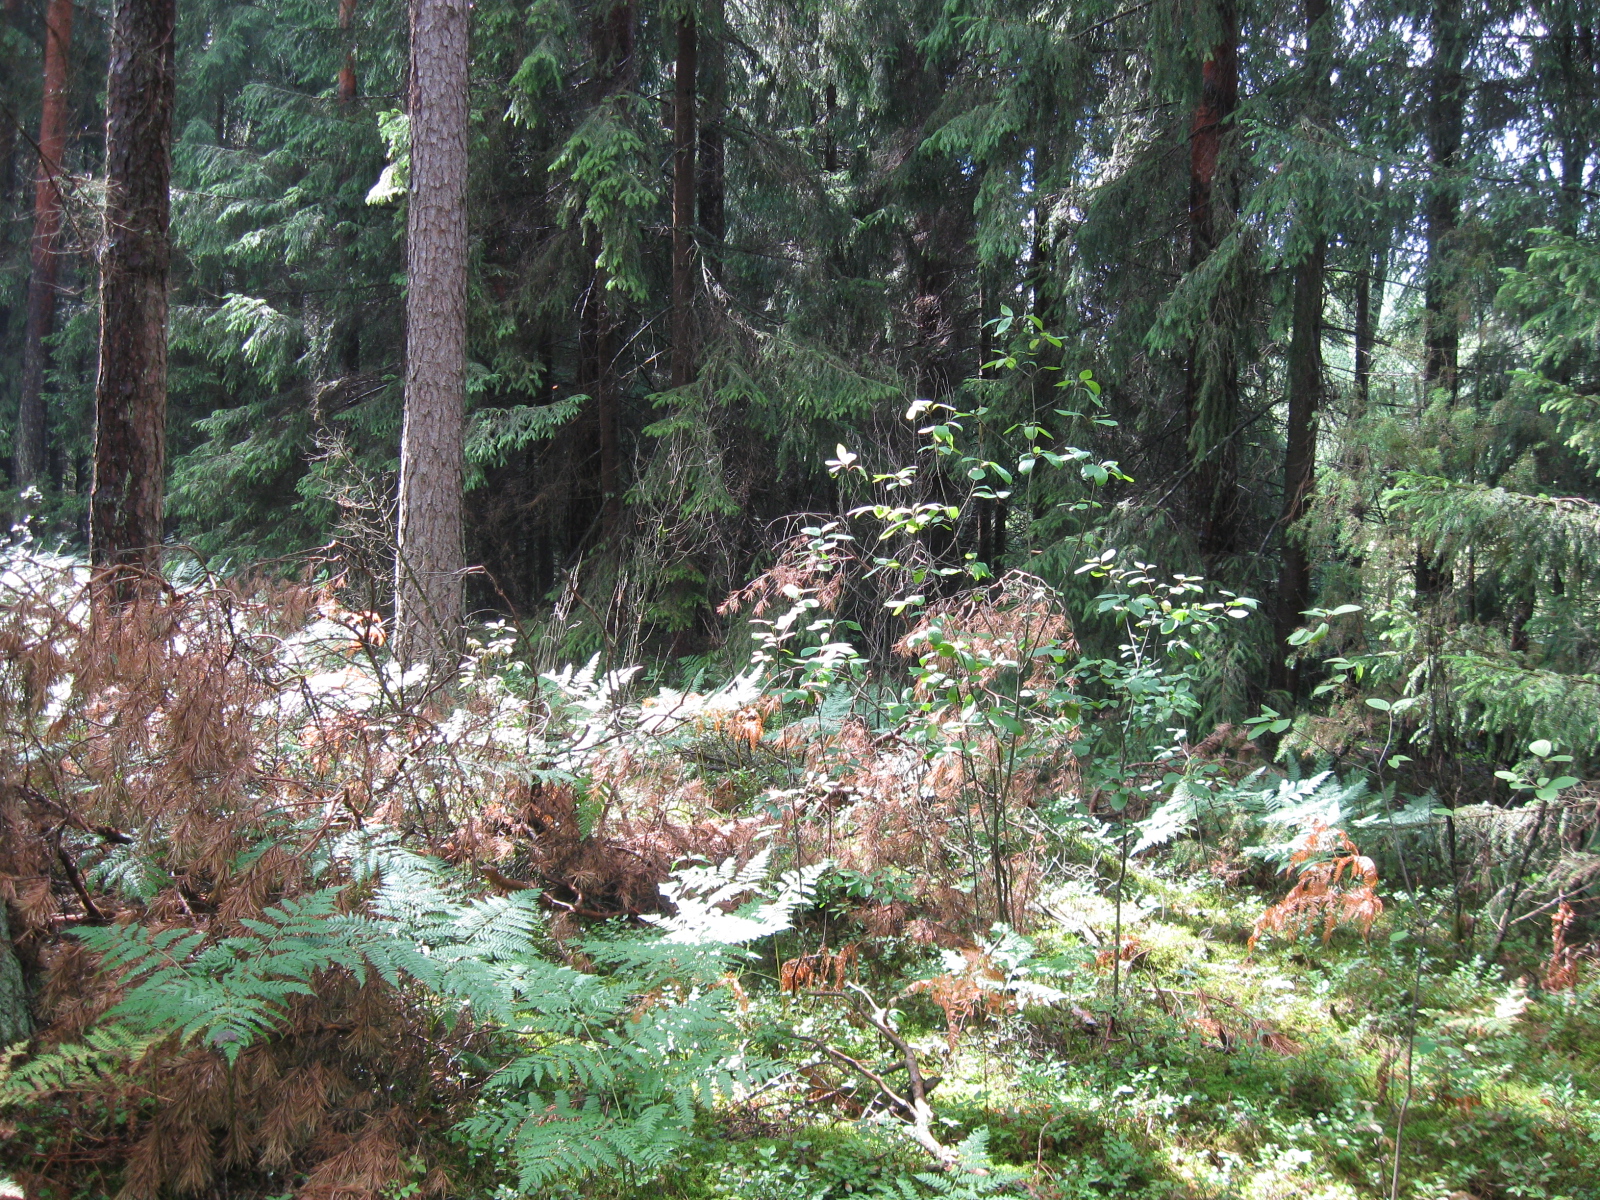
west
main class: Woodland
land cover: Other coniferous woodland
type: hemiboreal forest and nemoral coniferous forest and mixed broadleaved-coniferous forest
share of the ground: > 75 %
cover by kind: coniferous forest trees 80 %, lichens and mosses 10 %, broadleaved forest trees 5 %, herbaceous plants 5 %
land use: Forestry
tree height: > 5 m
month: July
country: LT
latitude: 53.9582
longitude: 23.6343
